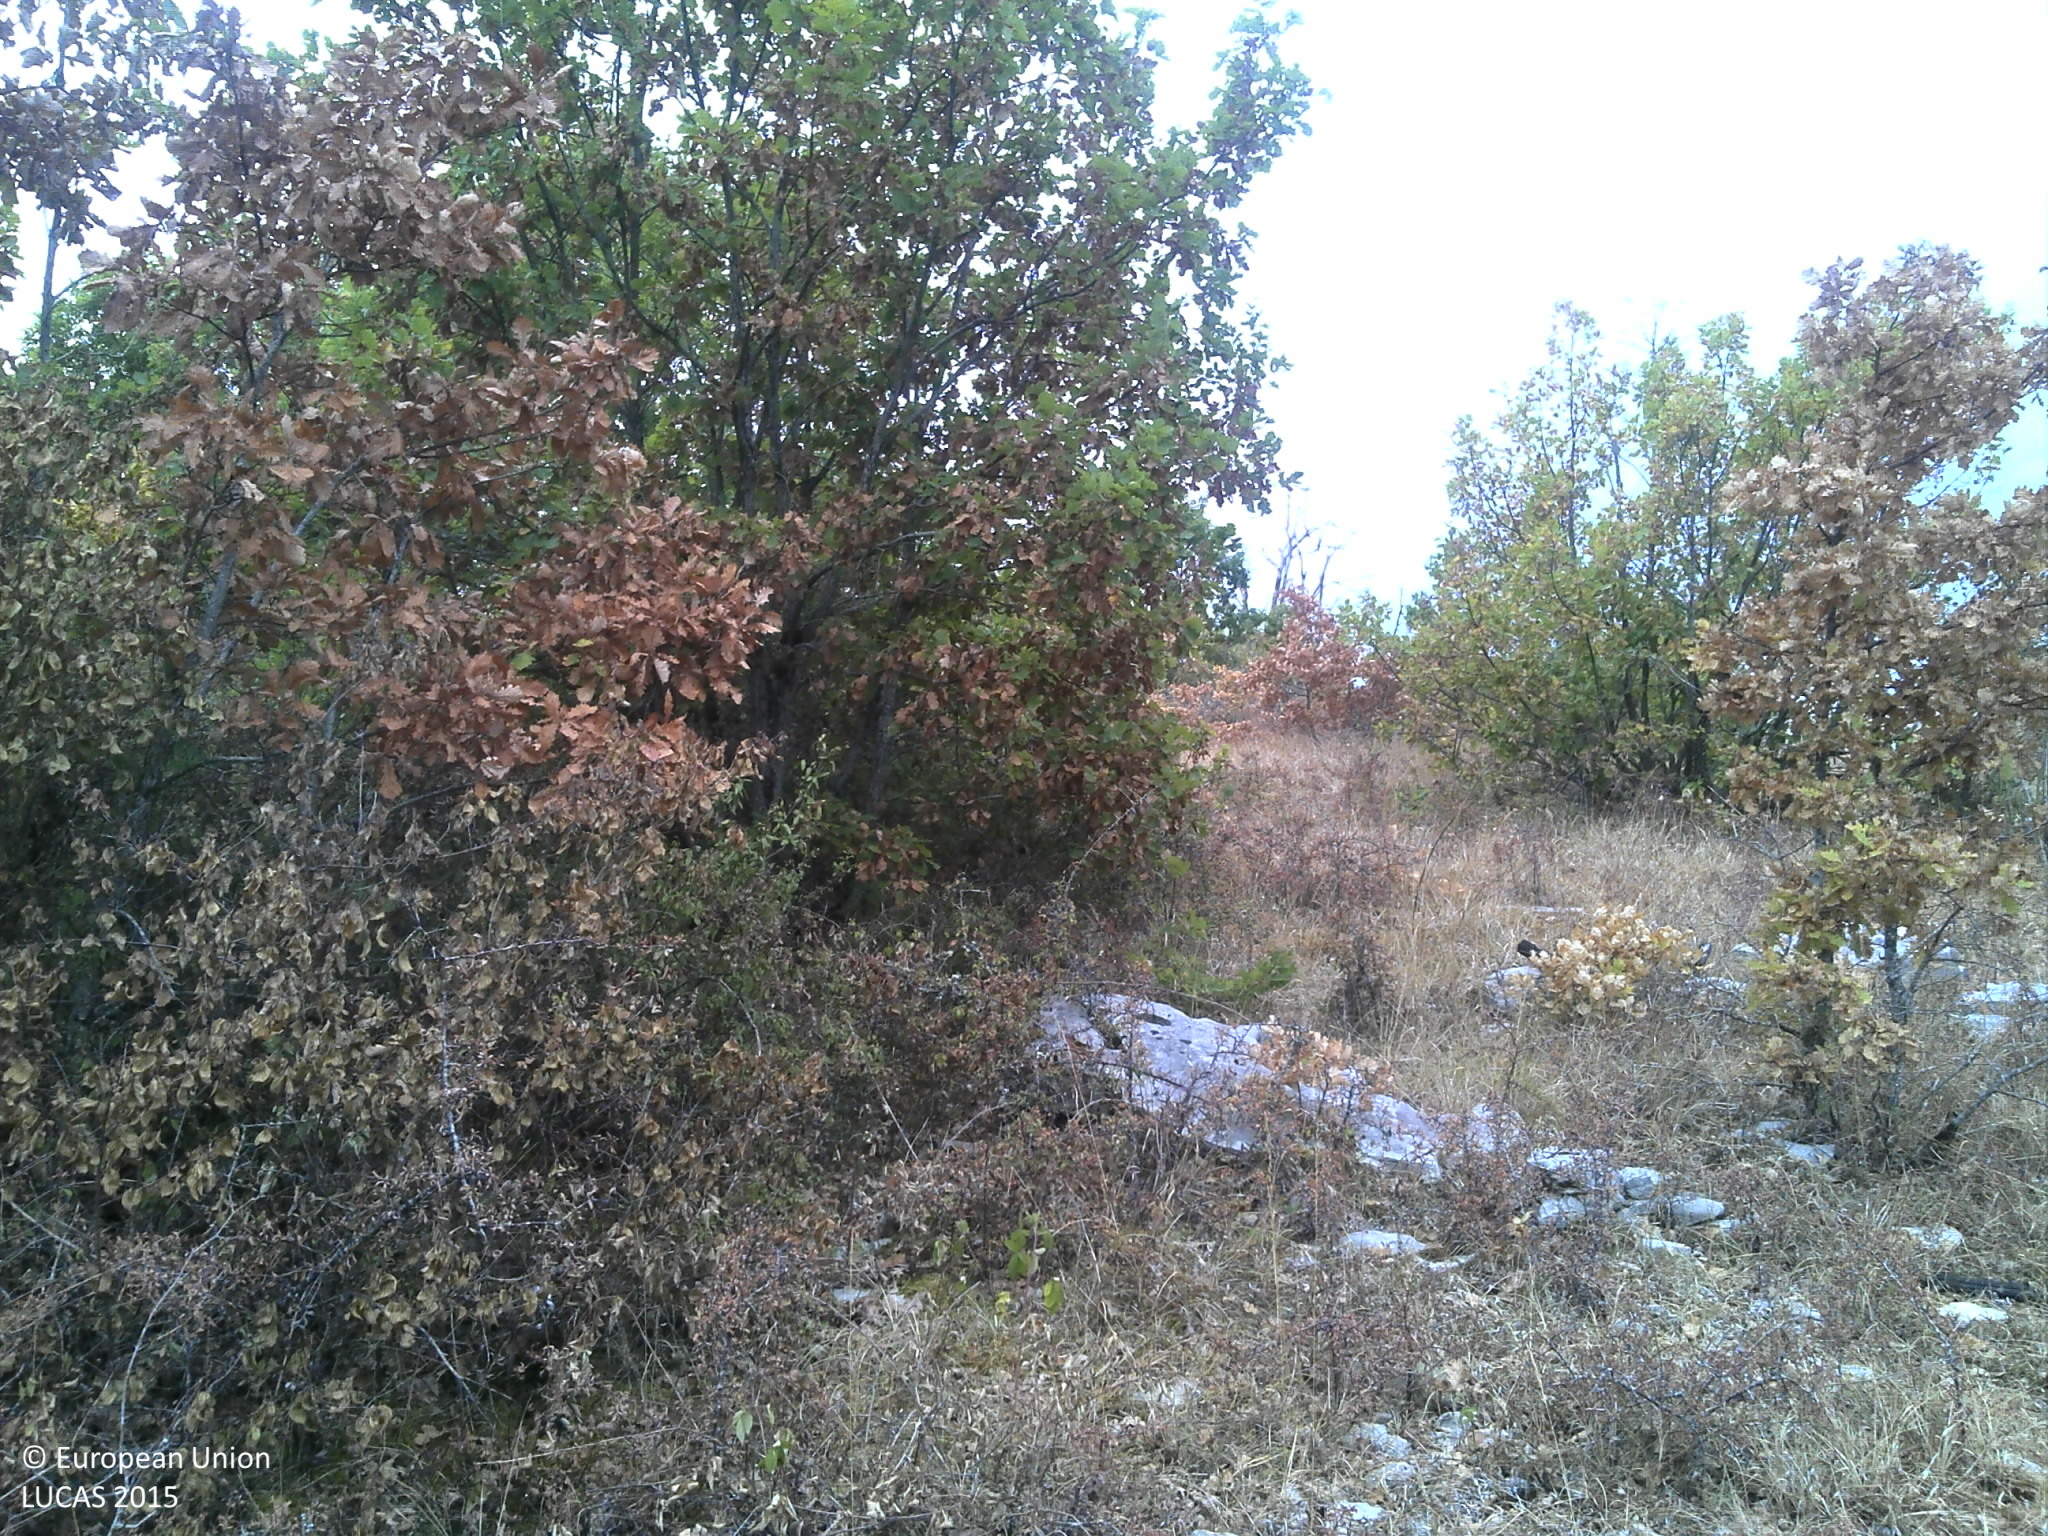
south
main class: Shrubland
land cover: Shrubland with sparse tree cover
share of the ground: > 75 %
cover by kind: shrubs 50 %, herbaceous plants 40 %, broadleaved forest trees 5 %, lichens and mosses 5 %
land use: Semi-natural and natural areas not in use
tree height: < 5 m
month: July
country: FR
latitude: 45.0821
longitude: 1.4198
